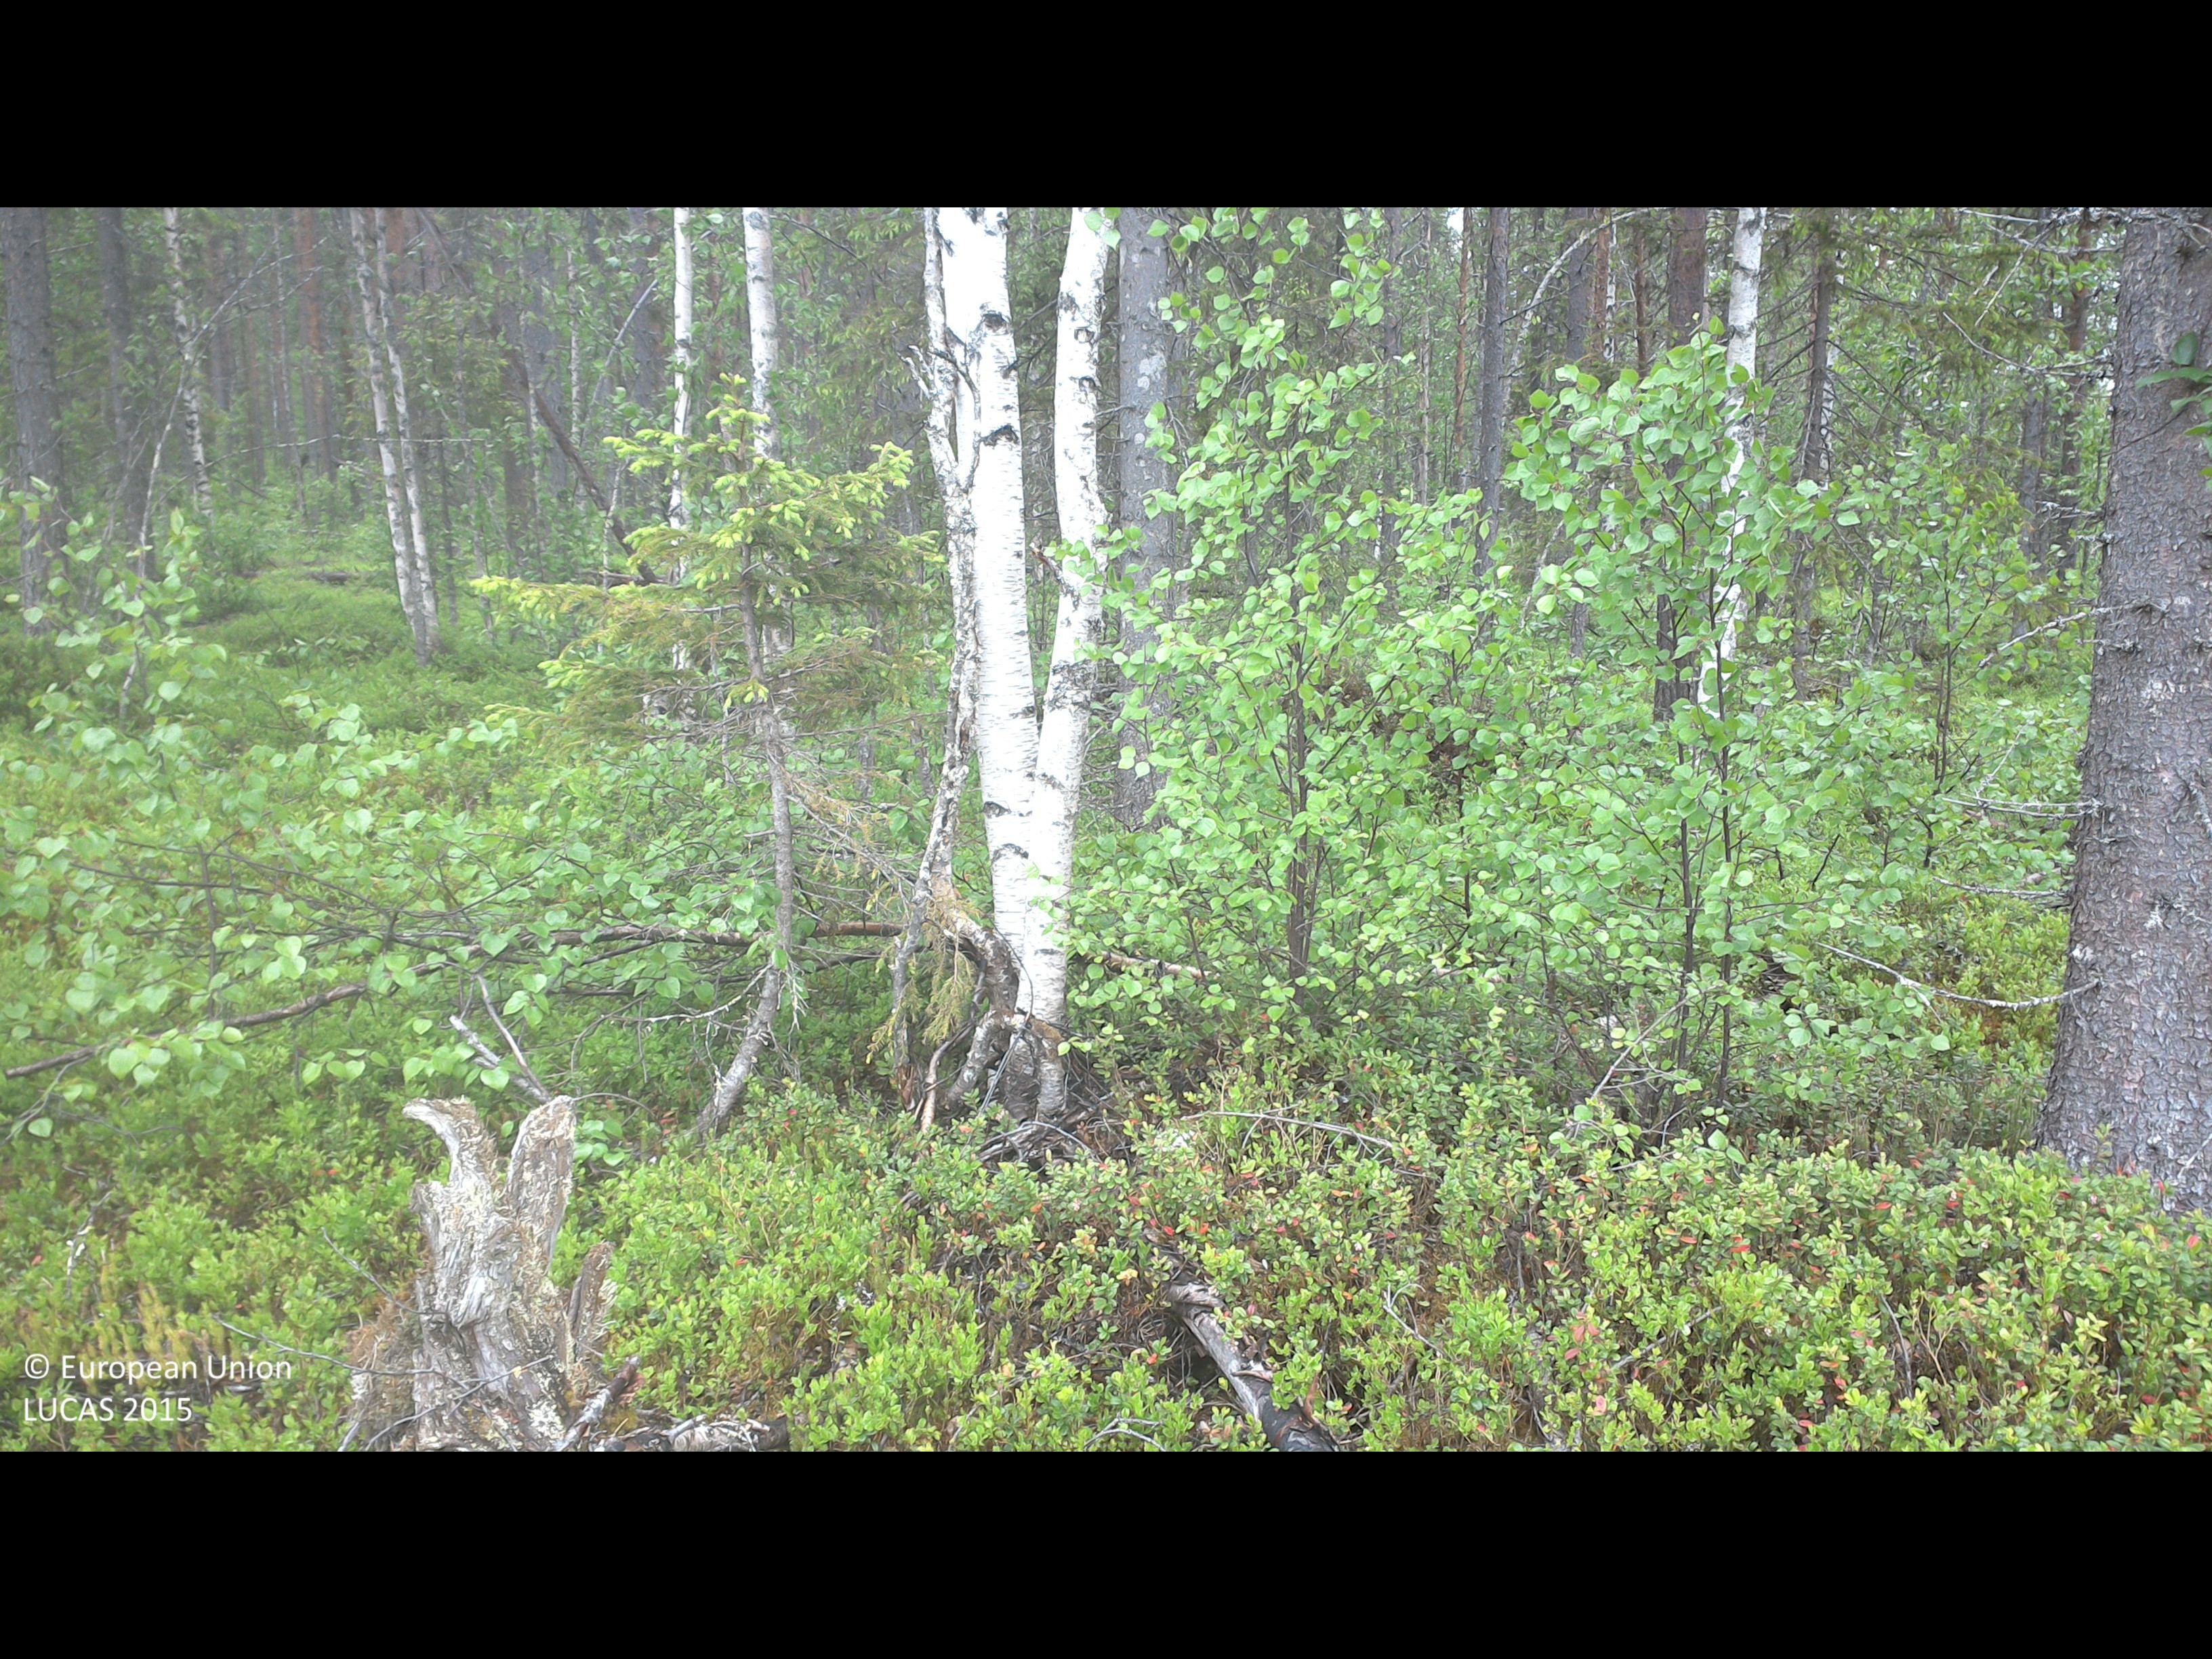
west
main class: Woodland
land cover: Pine dominated mixed woodland
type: boreal forest
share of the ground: 25 - 50 %
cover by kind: shrubs 70 %, coniferous forest trees 20 %, broadleaved forest trees 10 %
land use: Forestry
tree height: > 5 m
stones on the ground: < 10 %
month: June
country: SE
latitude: 66.8909
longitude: 22.5475
